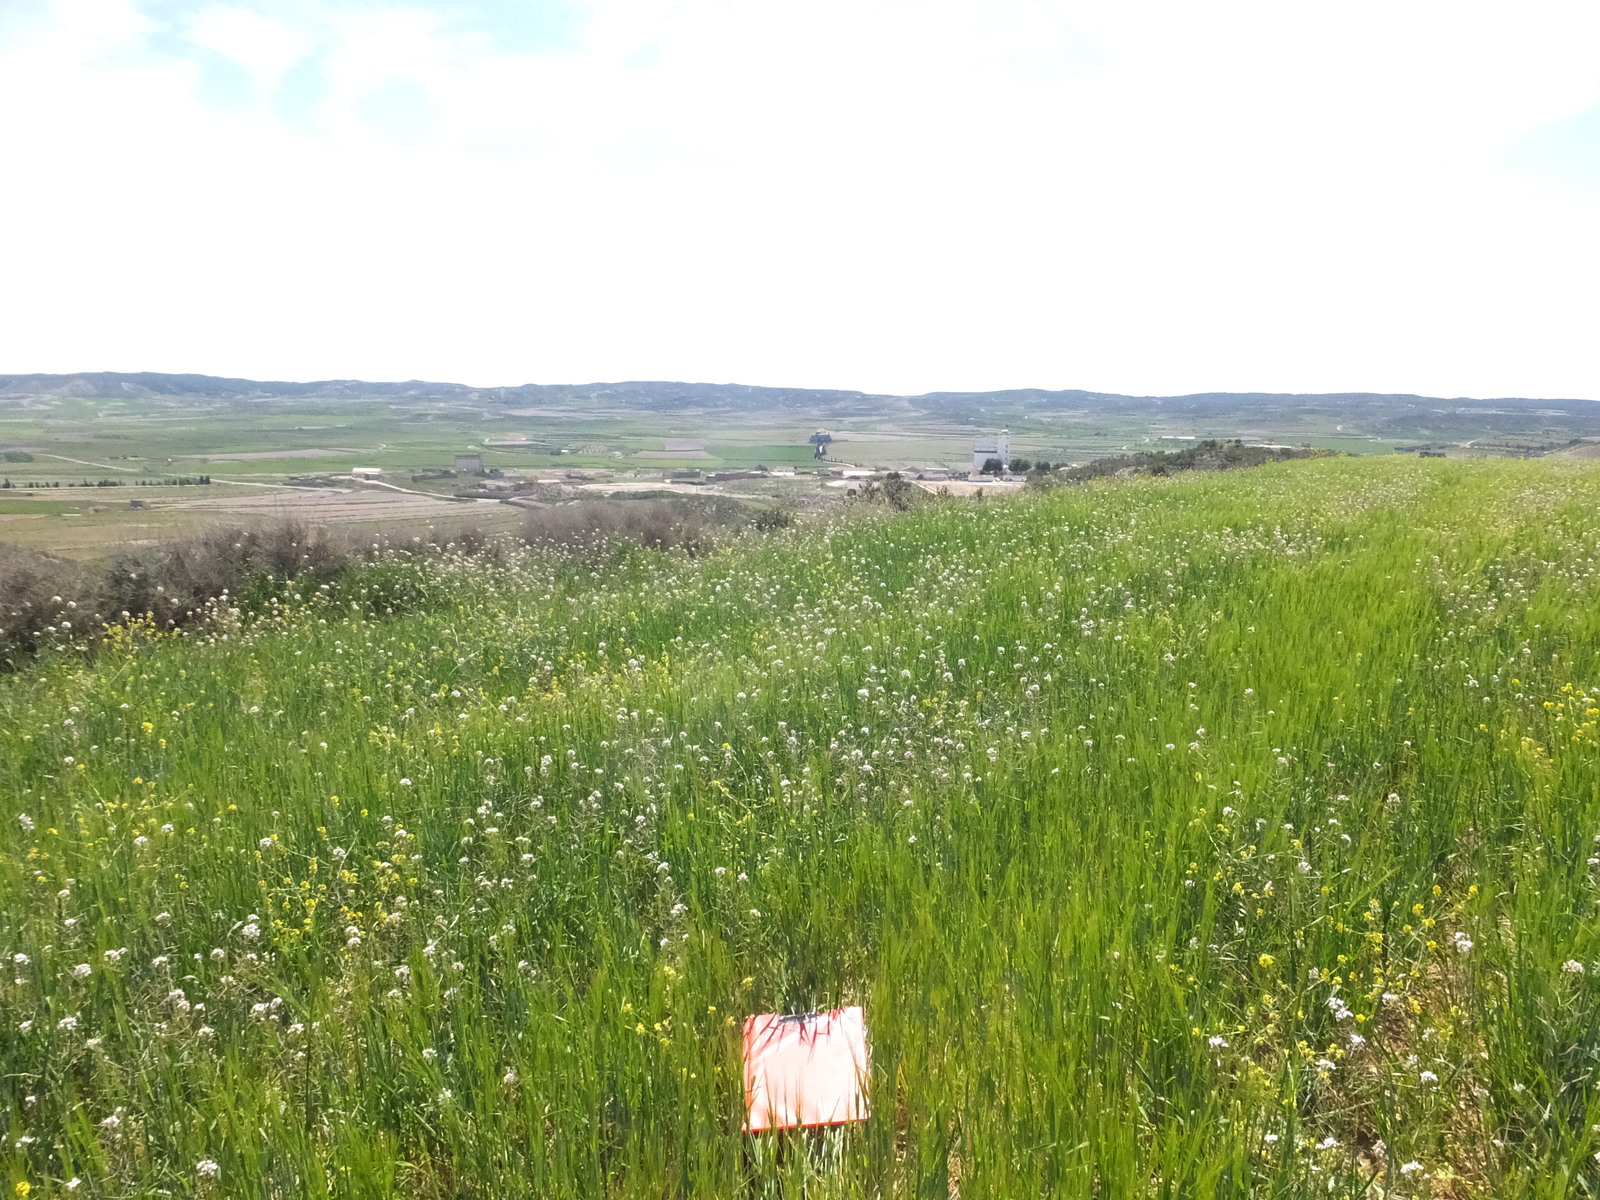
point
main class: Cropland
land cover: Barley
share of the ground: > 75 %
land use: Agriculture (excluding fallow land and kitchen gardens)
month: April
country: ES
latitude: 41.6251
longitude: -0.2312
